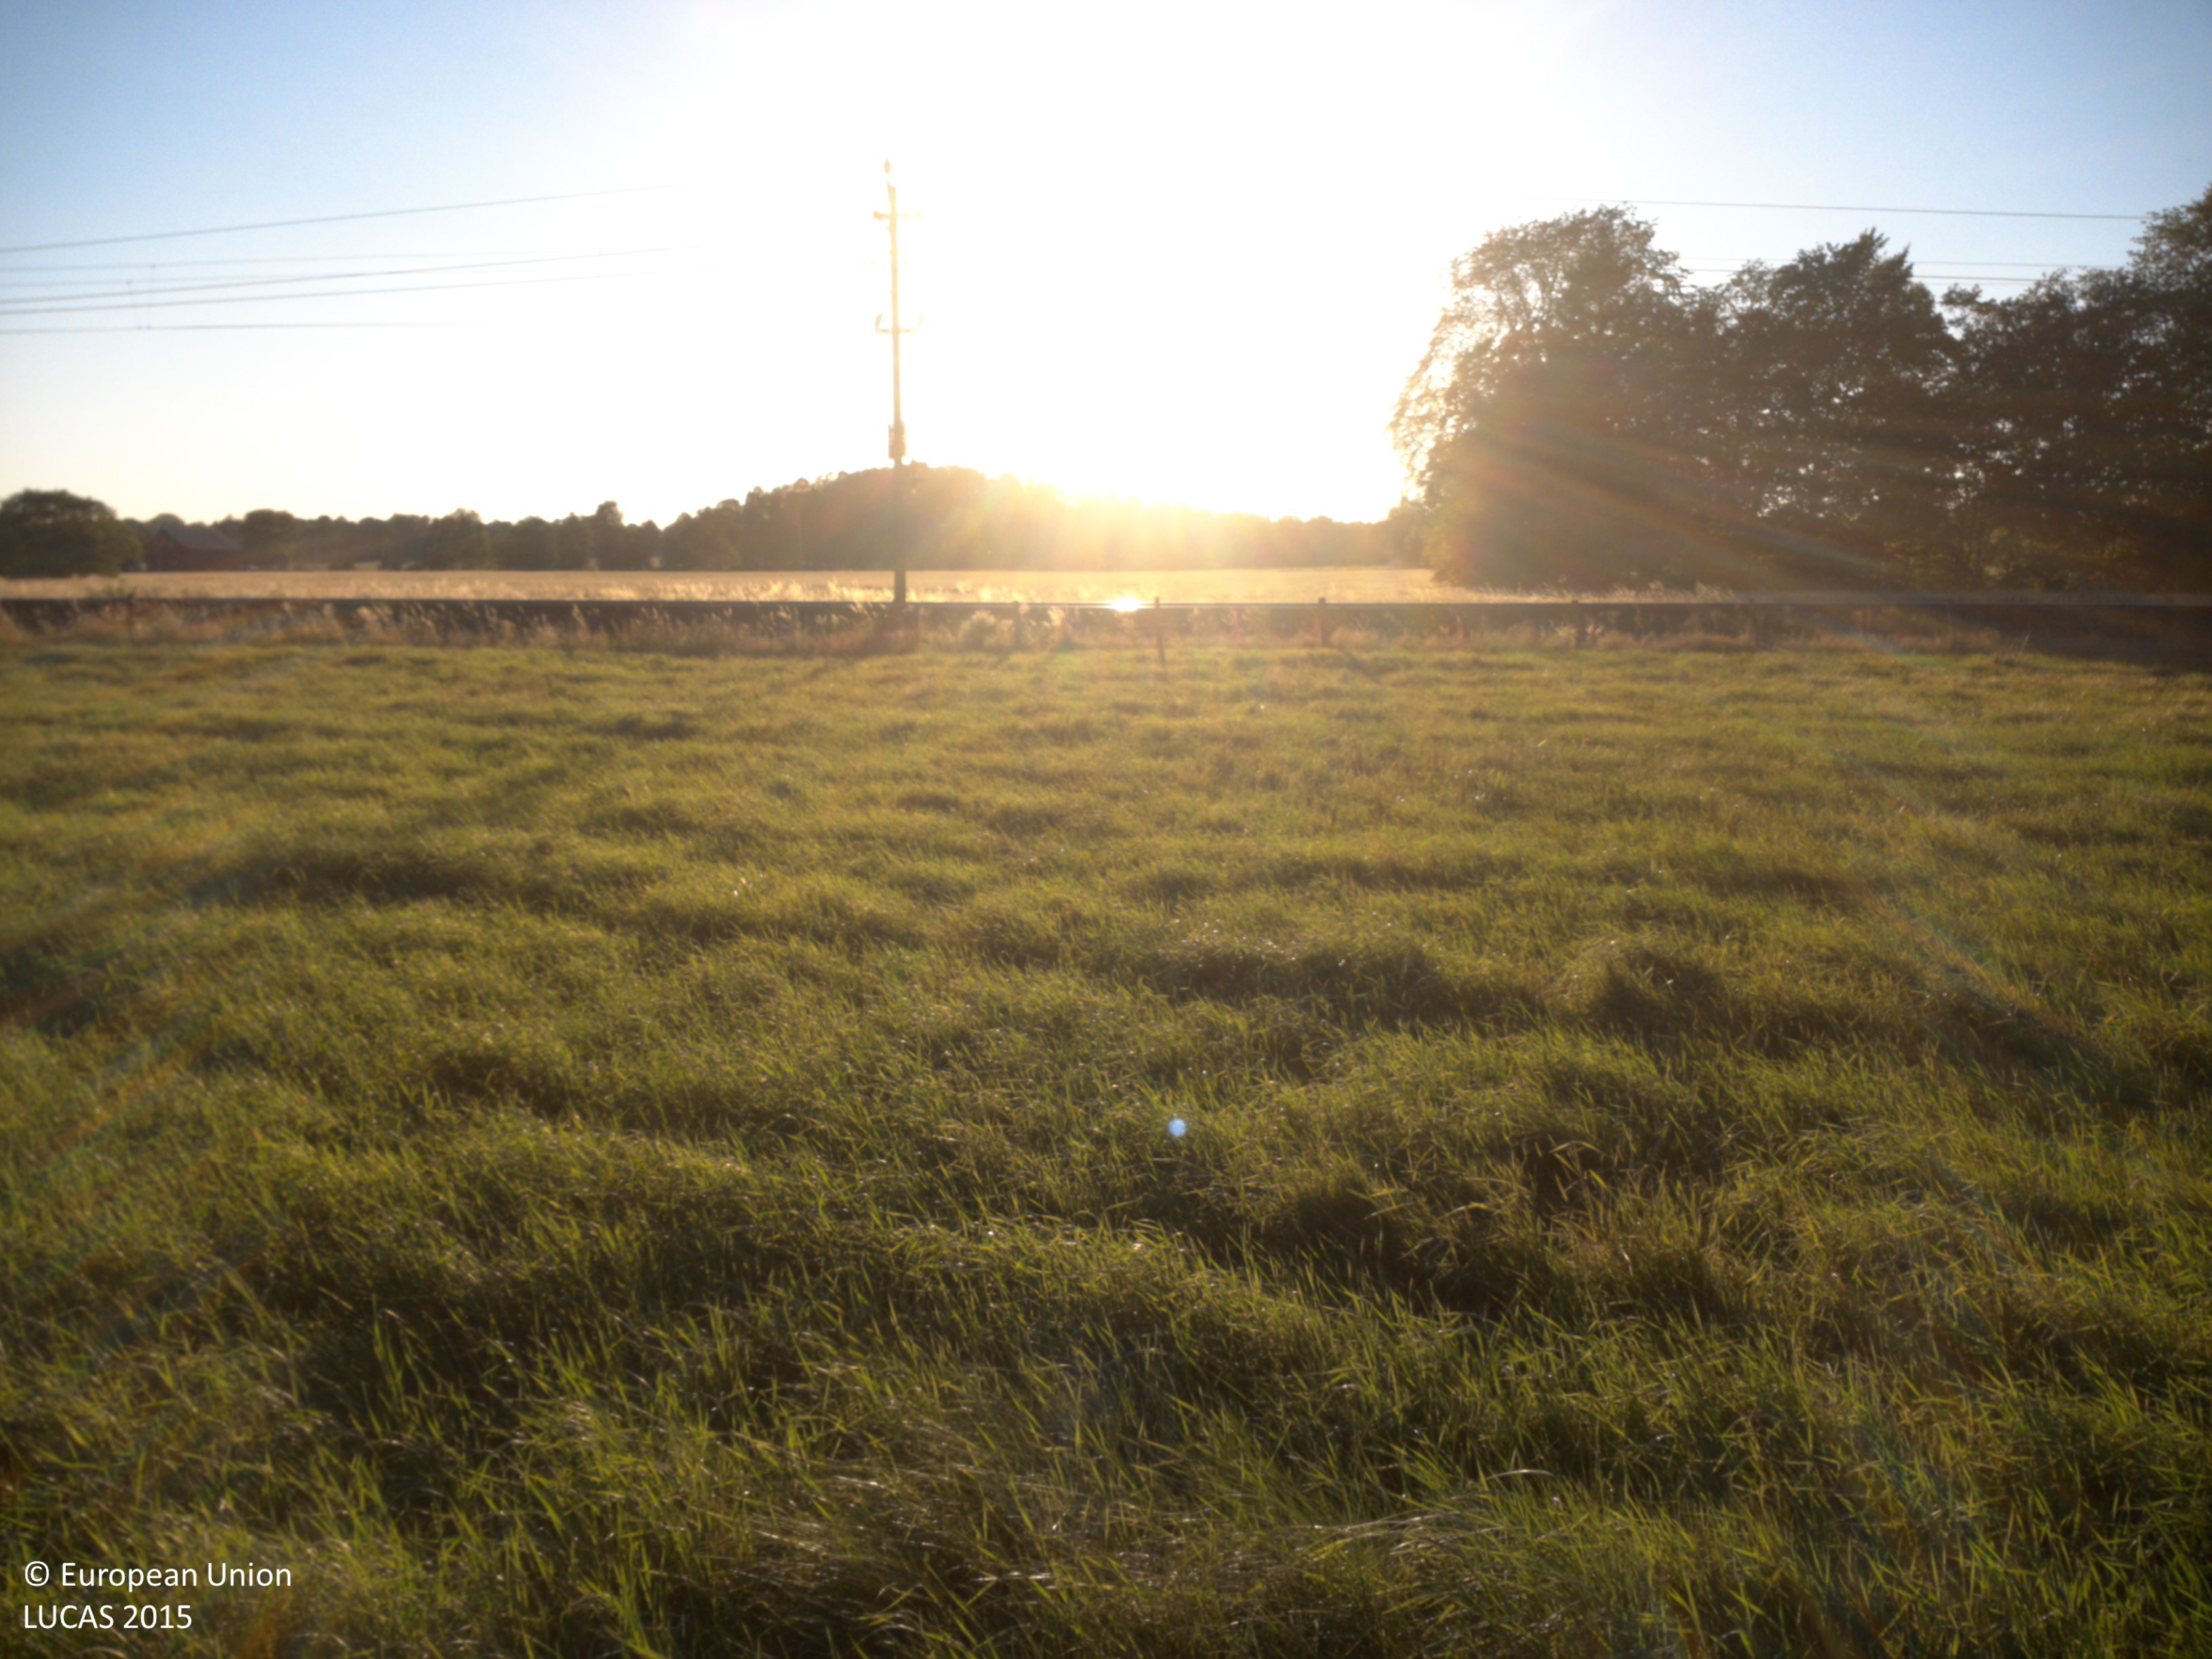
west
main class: Grassland
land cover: Grassland without tree/shrub cover
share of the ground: > 75 %
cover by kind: herbaceous plants 100 %
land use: Agriculture (excluding fallow land and kitchen gardens)
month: August
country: SE
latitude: 58.4881
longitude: 12.2768
